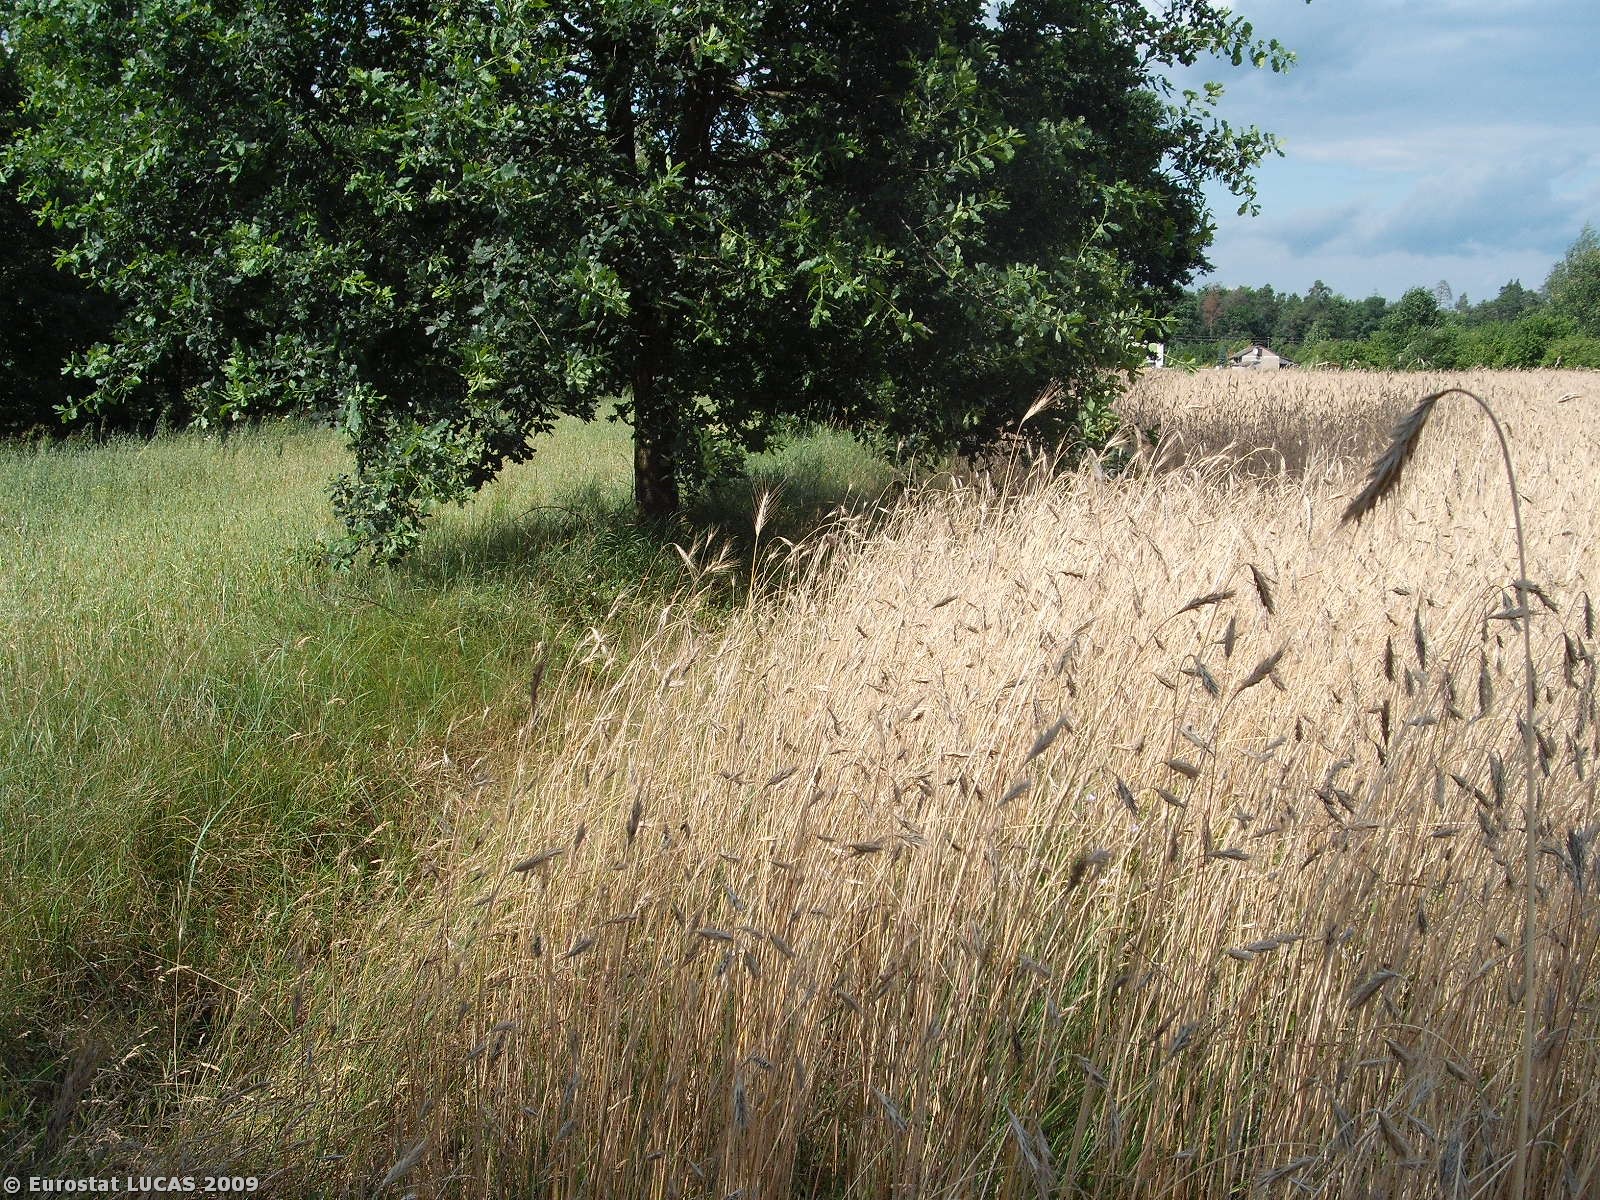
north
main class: Cropland
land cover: Rye
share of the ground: > 75 %
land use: Agriculture (excluding fallow land and kitchen gardens)
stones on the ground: < 10 %
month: July
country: PL
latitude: 51.3625
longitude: 21.4978
